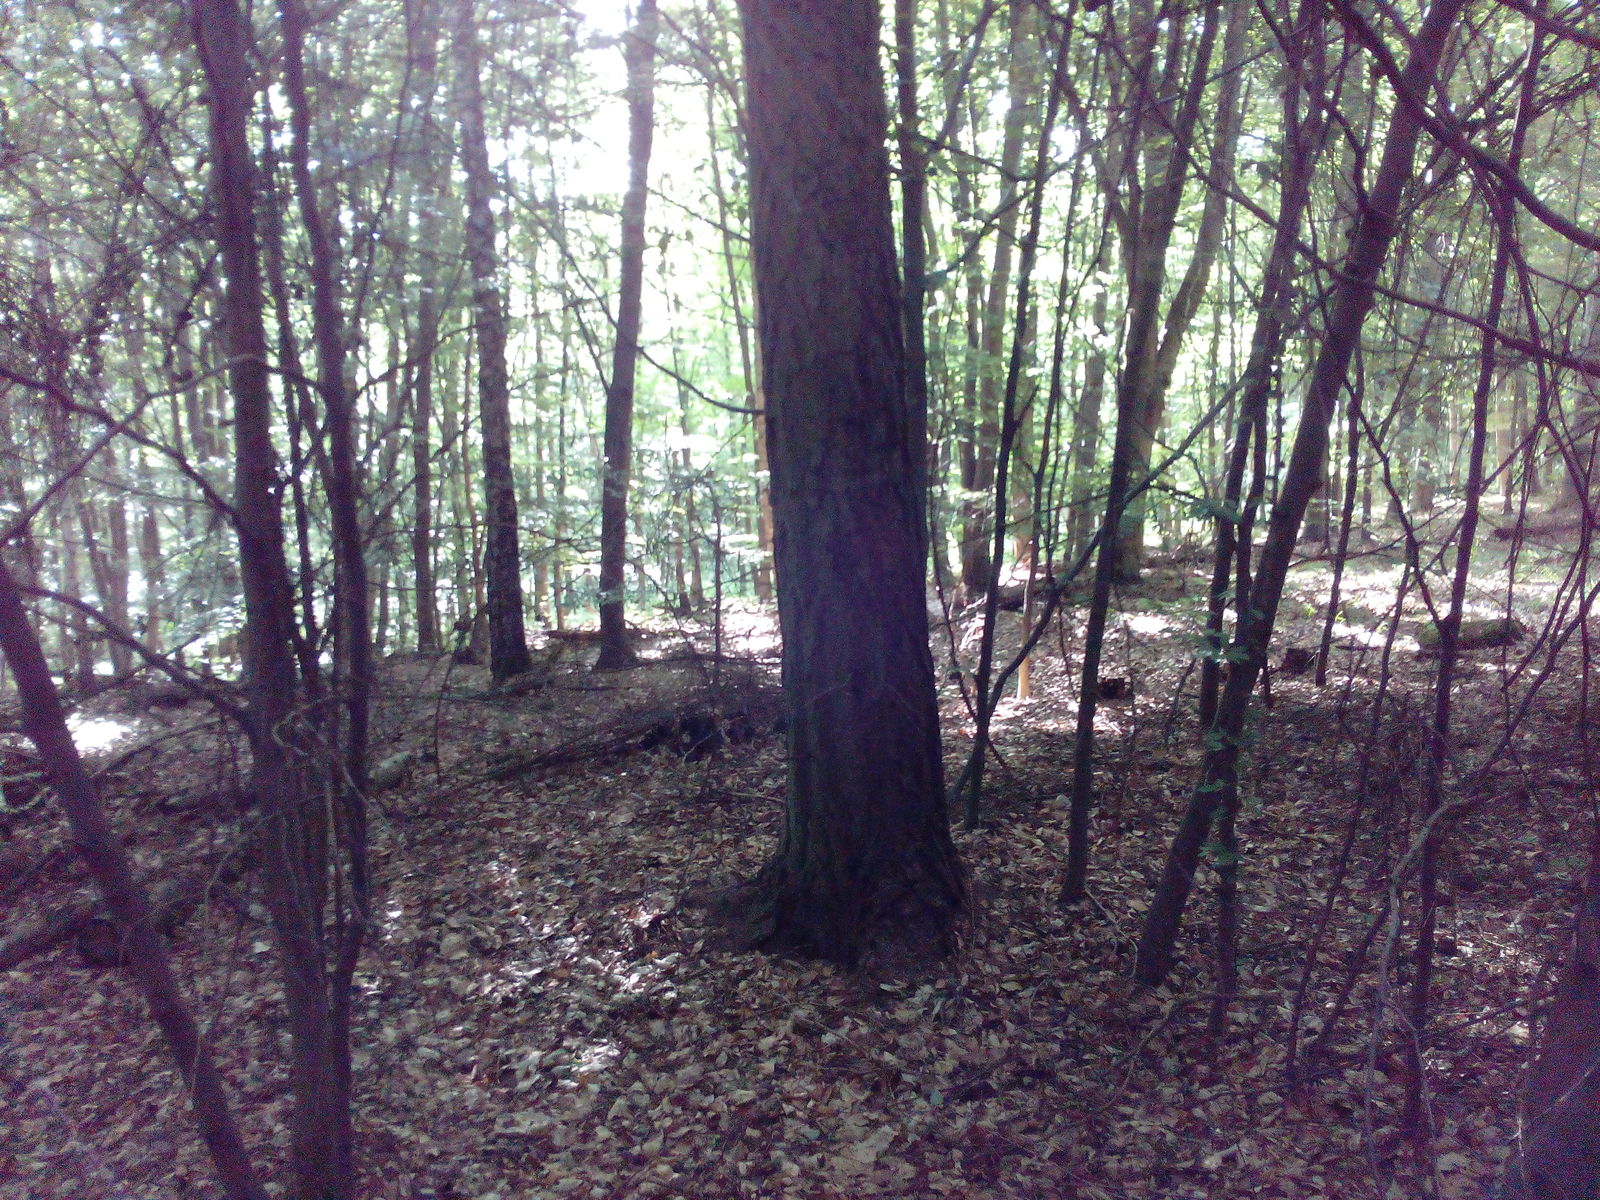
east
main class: Woodland
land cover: Other mixed woodland
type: hemiboreal forest and nemoral coniferous forest and mixed broadleaved-coniferous forest
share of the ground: 50 - 75 %
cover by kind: broadleaved forest trees 70 %, coniferous forest trees 30 %
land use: Forestry
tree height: > 5 m
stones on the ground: < 10 %
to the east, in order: Other mixed woodland; Broadleaved woodland; Tracks; Broadleaved woodland
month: July
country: DE
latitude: 51.3130
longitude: 10.9610
